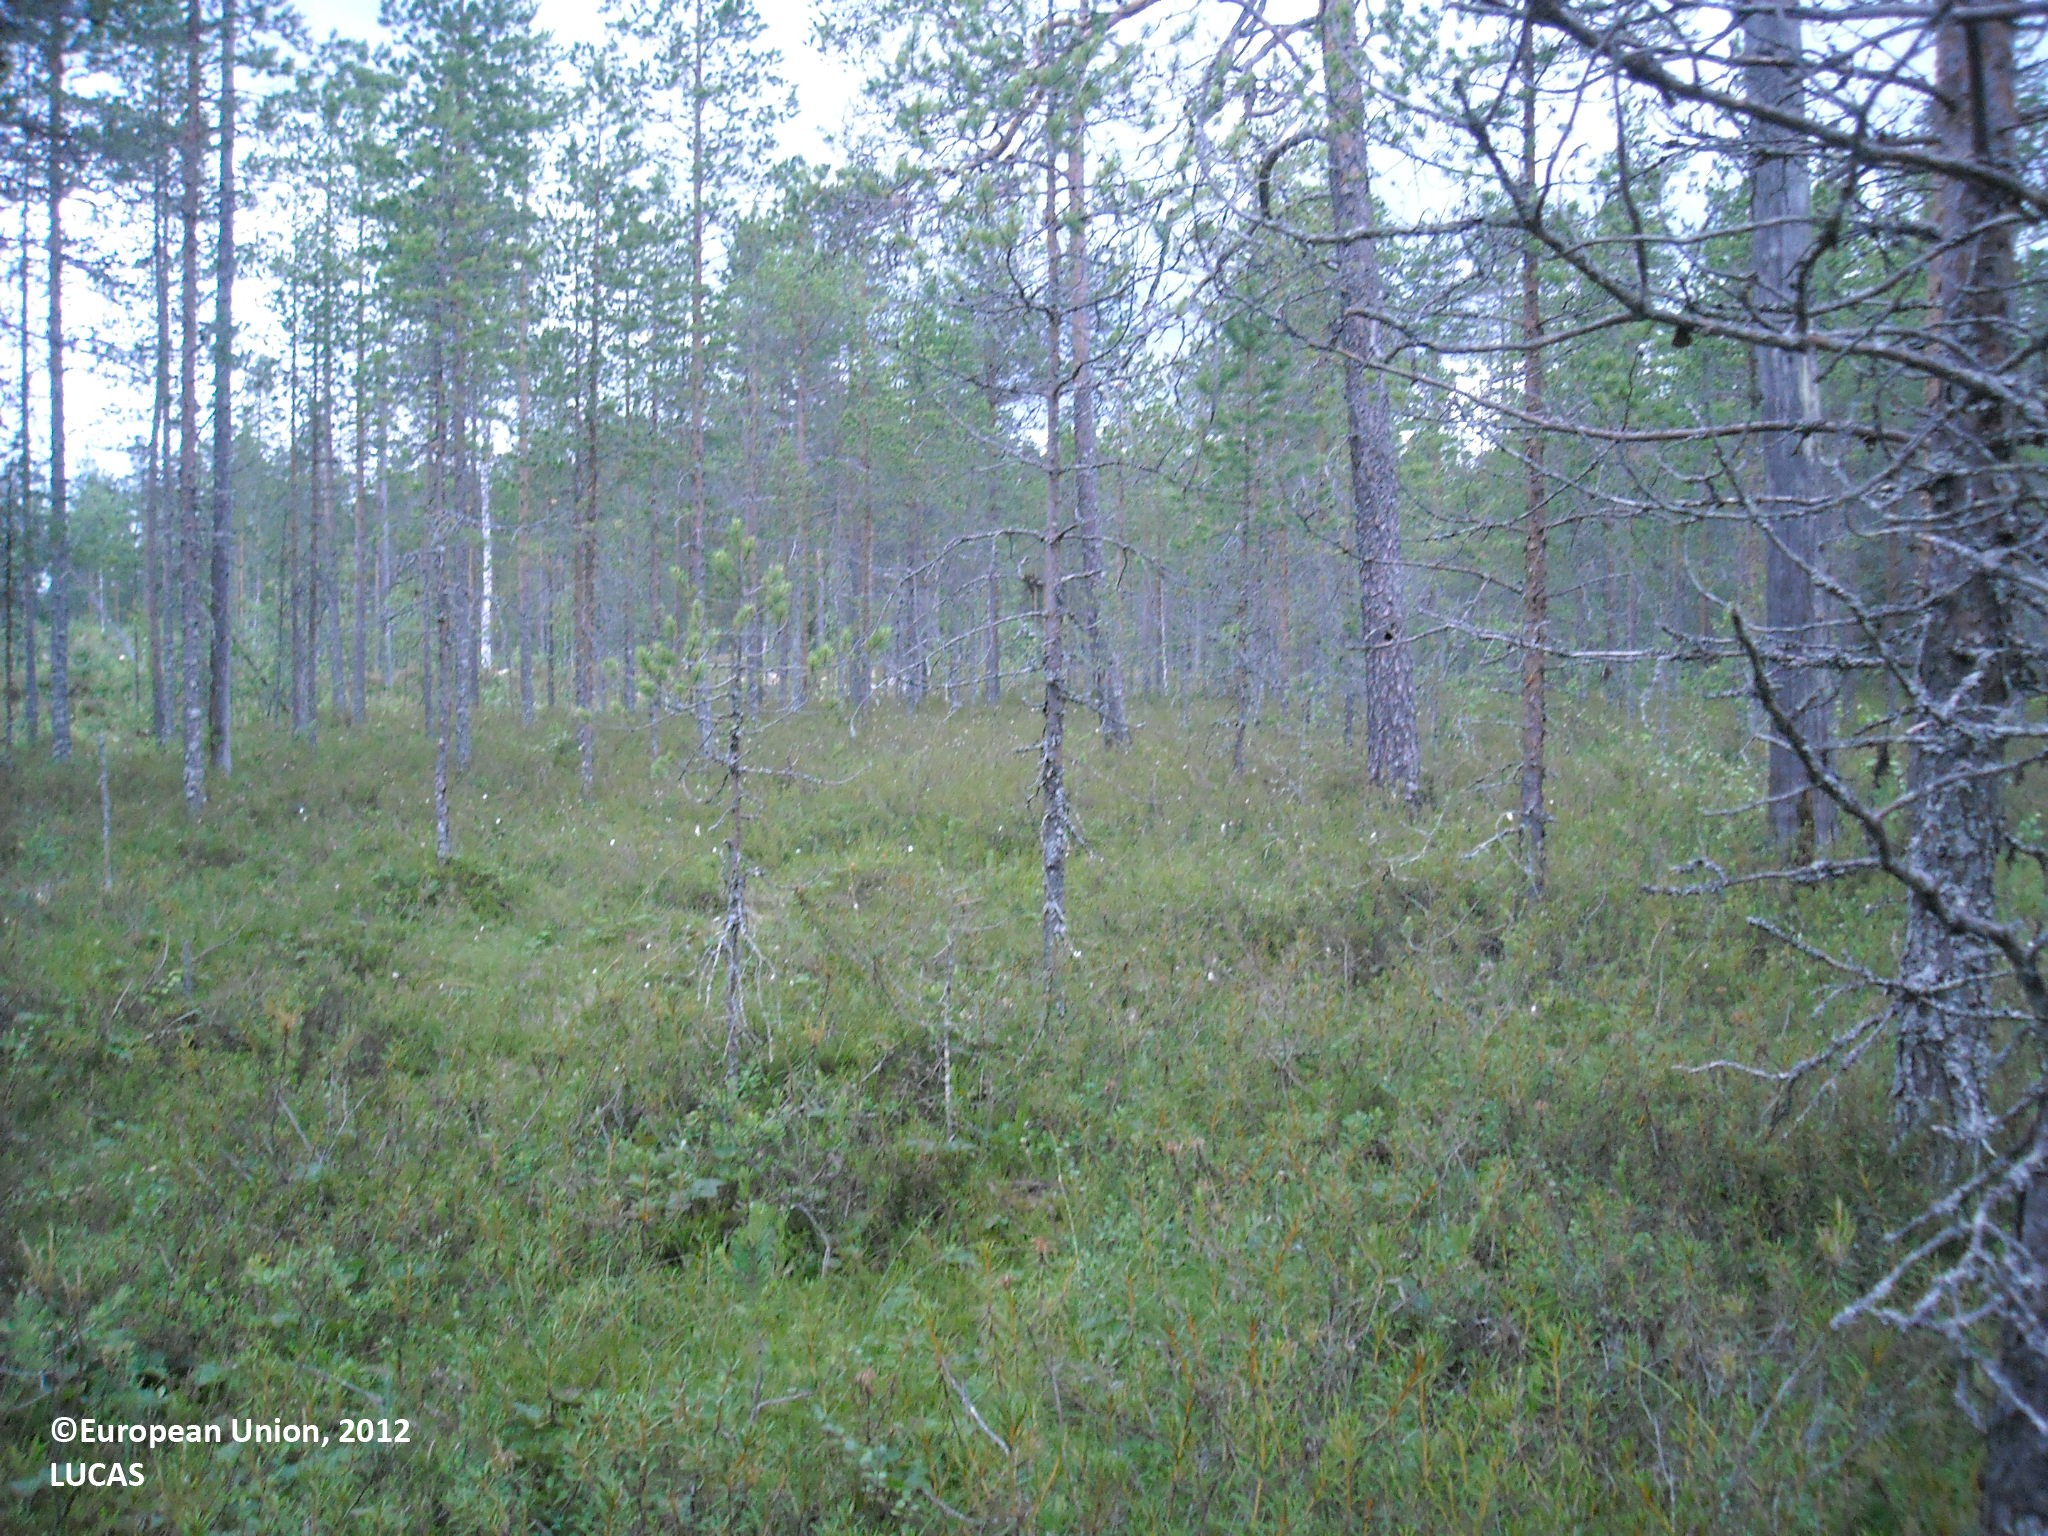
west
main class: Woodland
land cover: Pine dominated coniferous woodland
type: mire and swamp forests
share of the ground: 50 - 75 %
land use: Forestry
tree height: > 5 m
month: July
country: FI
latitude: 65.0354
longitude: 26.7845
